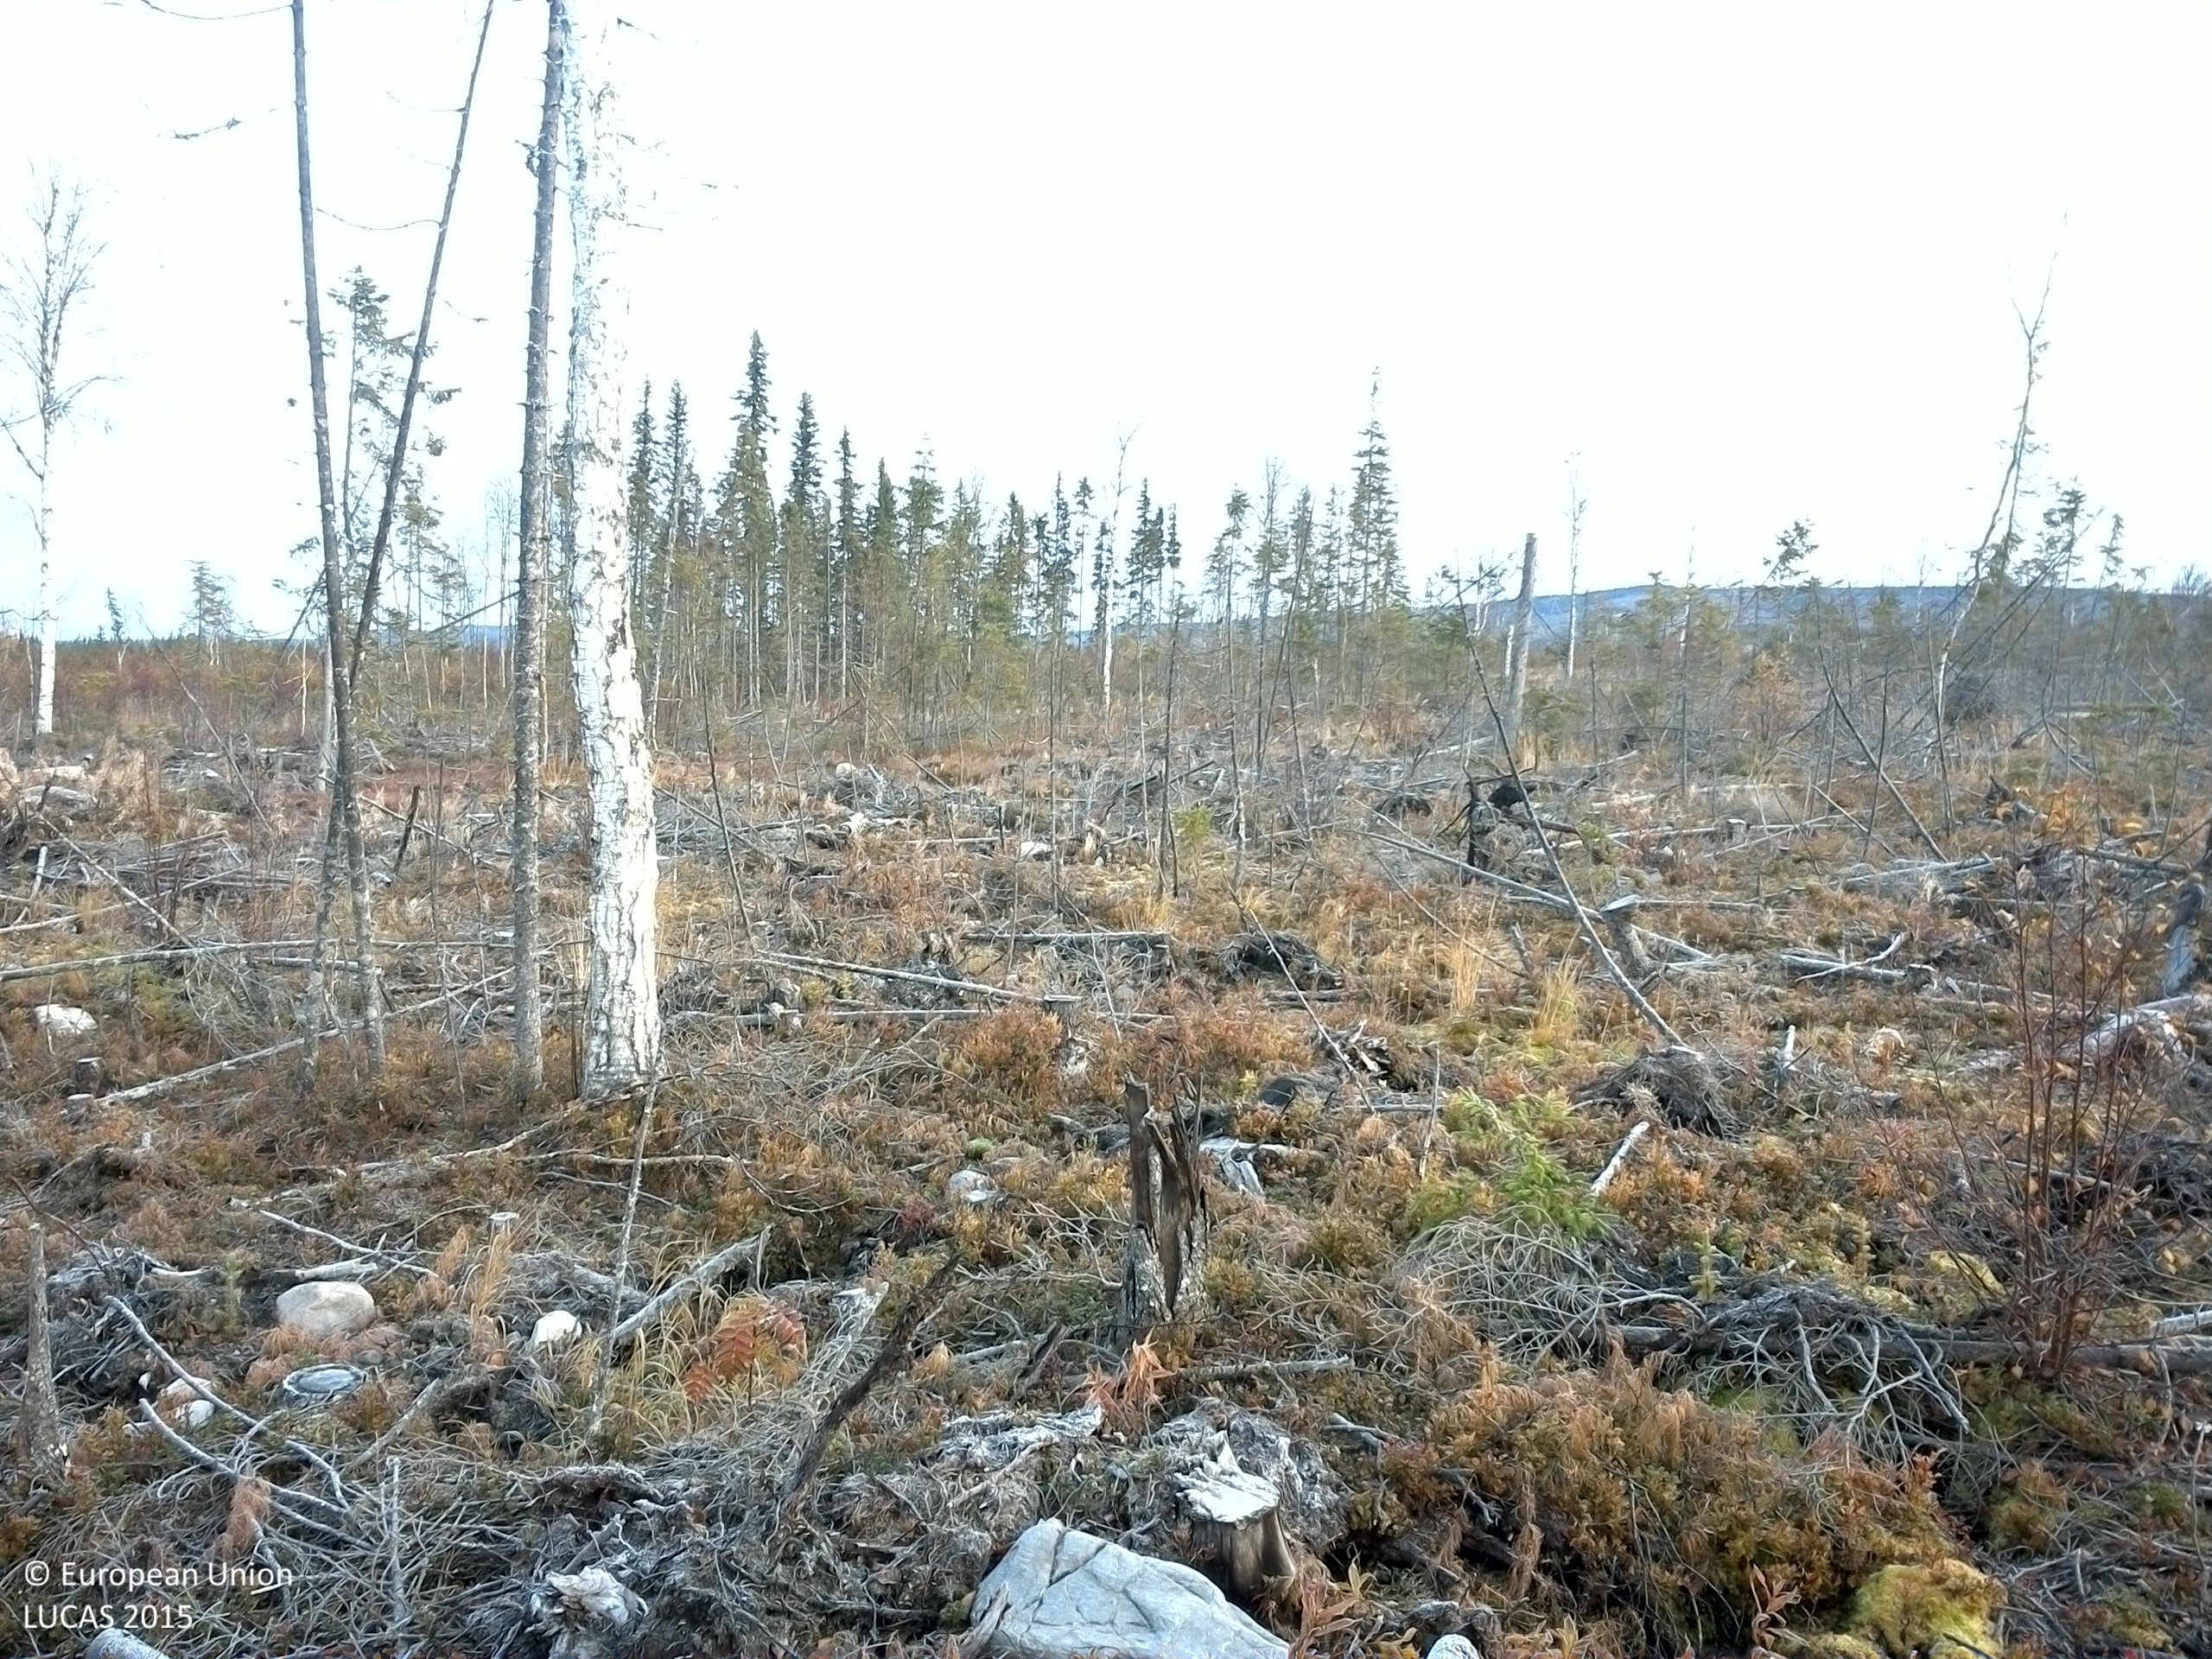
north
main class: Woodland
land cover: Spruce dominated coniferous woodland
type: boreal forest
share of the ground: 10 - 25 %
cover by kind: lichens and mosses 30 %, shrubs 25 %, unconsolidated bare surface 25 %, coniferous forest trees 10 %, herbaceous plants 10 %
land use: Forestry
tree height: < 5 m
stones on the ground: < 10 %
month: October
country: SE
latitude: 64.1806
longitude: 15.8770
